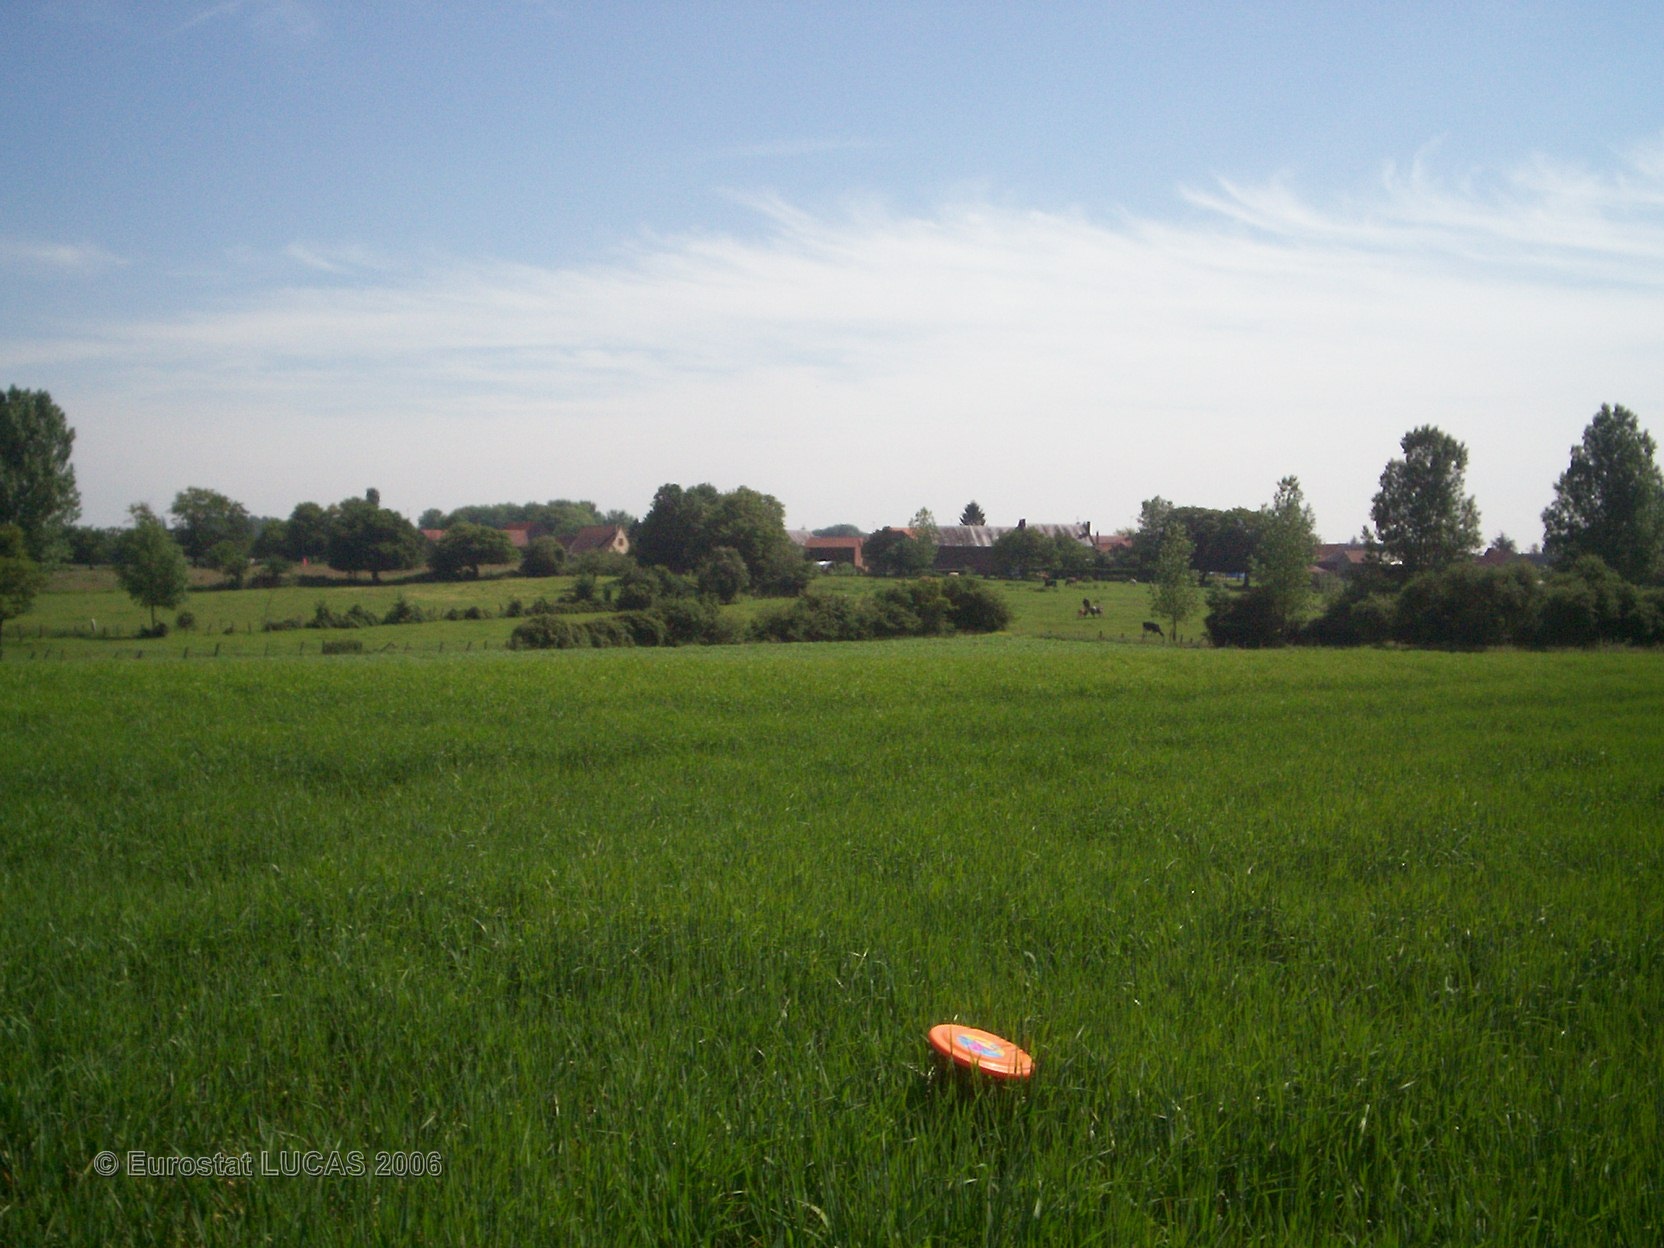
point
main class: Cropland
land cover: Oats
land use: Agriculture (excluding fallow land and kitchen gardens)
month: June
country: FR
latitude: 49.6086
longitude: 2.7238
